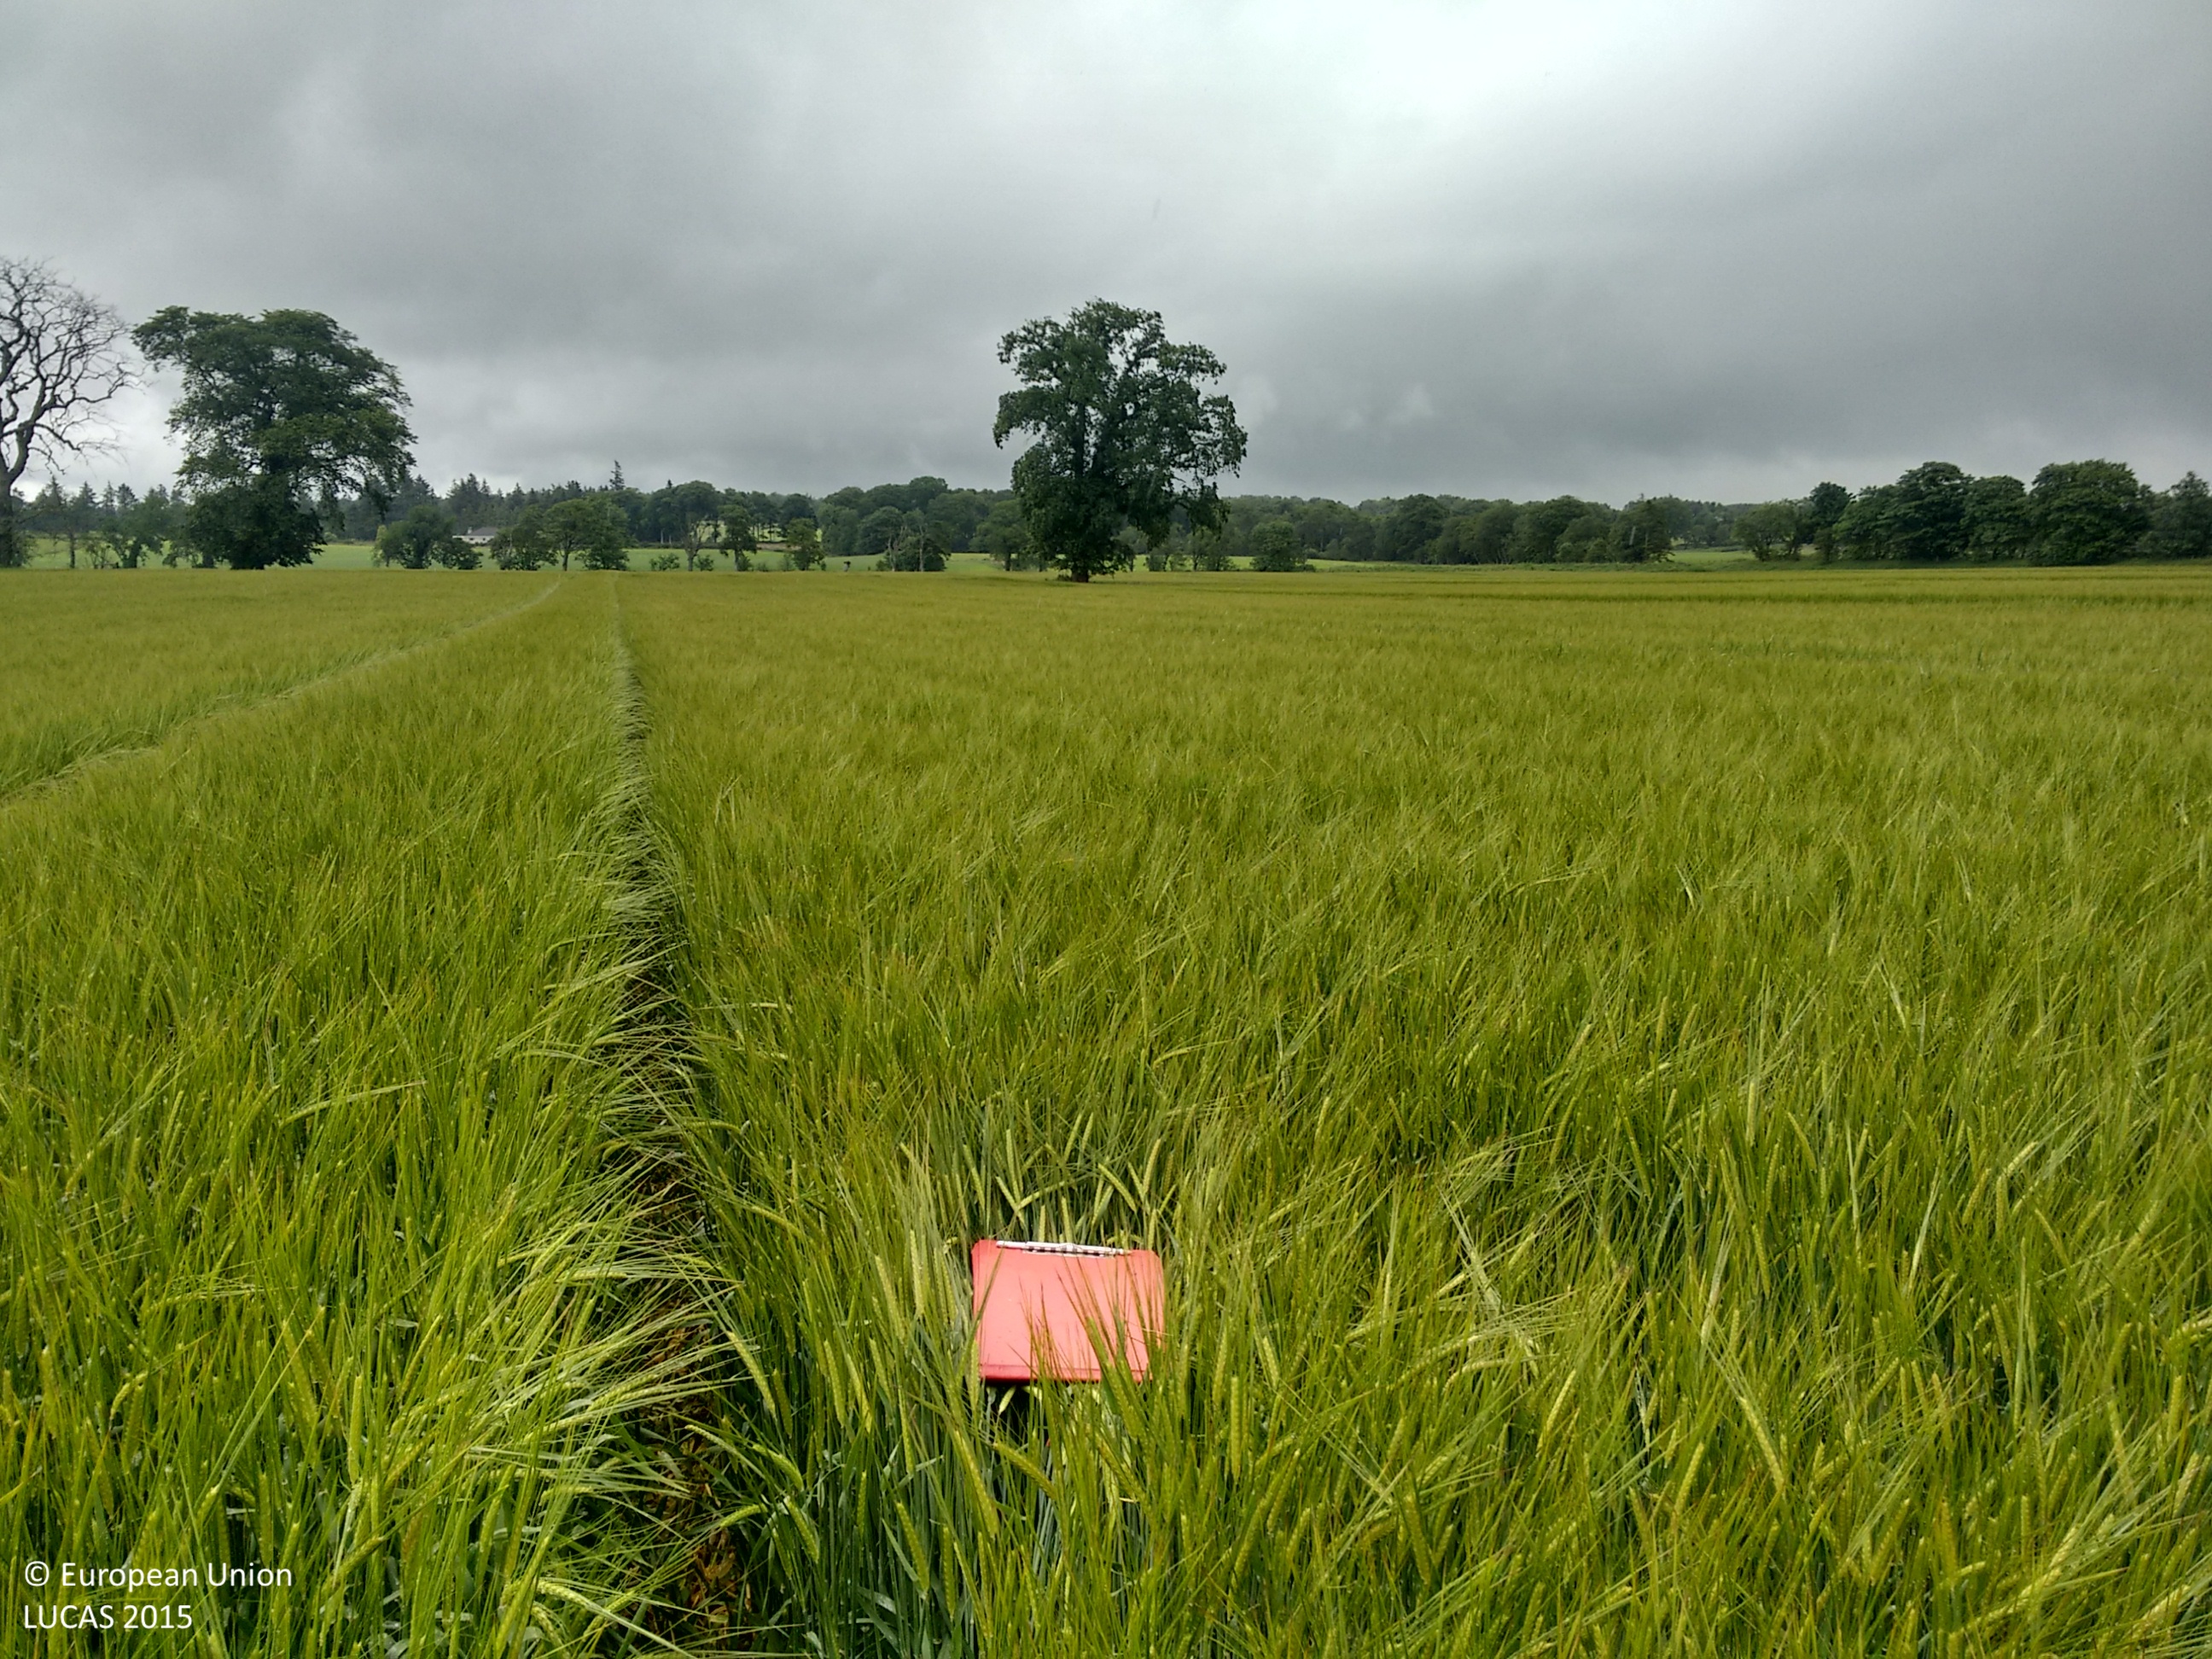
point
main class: Cropland
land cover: Barley
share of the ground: > 75 %
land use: Agriculture (excluding fallow land and kitchen gardens)
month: July
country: GB
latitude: 57.2333
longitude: -2.2934
